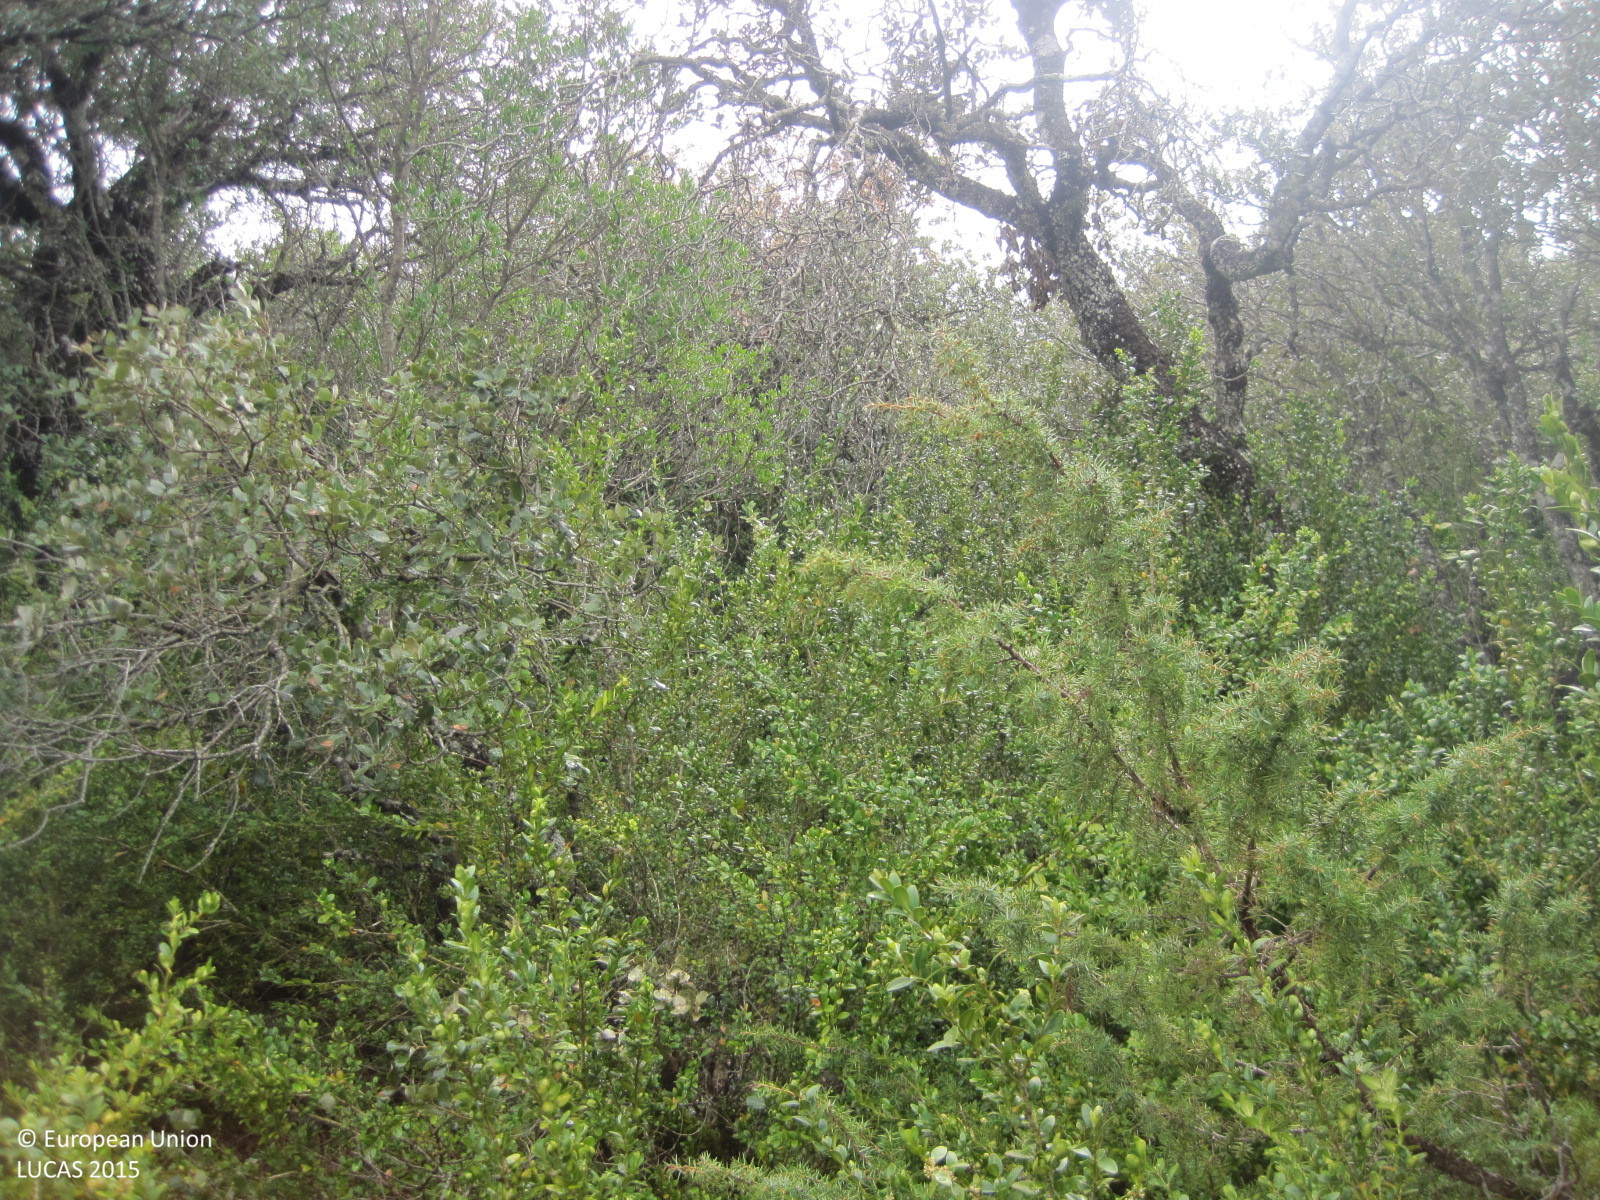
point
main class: Woodland
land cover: Broadleaved woodland
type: broadleaved evergreen forest
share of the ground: > 75 %
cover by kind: broadleaved forest trees 100 %
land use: Semi-natural and natural areas not in use
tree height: > 5 m
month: April
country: ES
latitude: 42.6842
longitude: -2.1625
